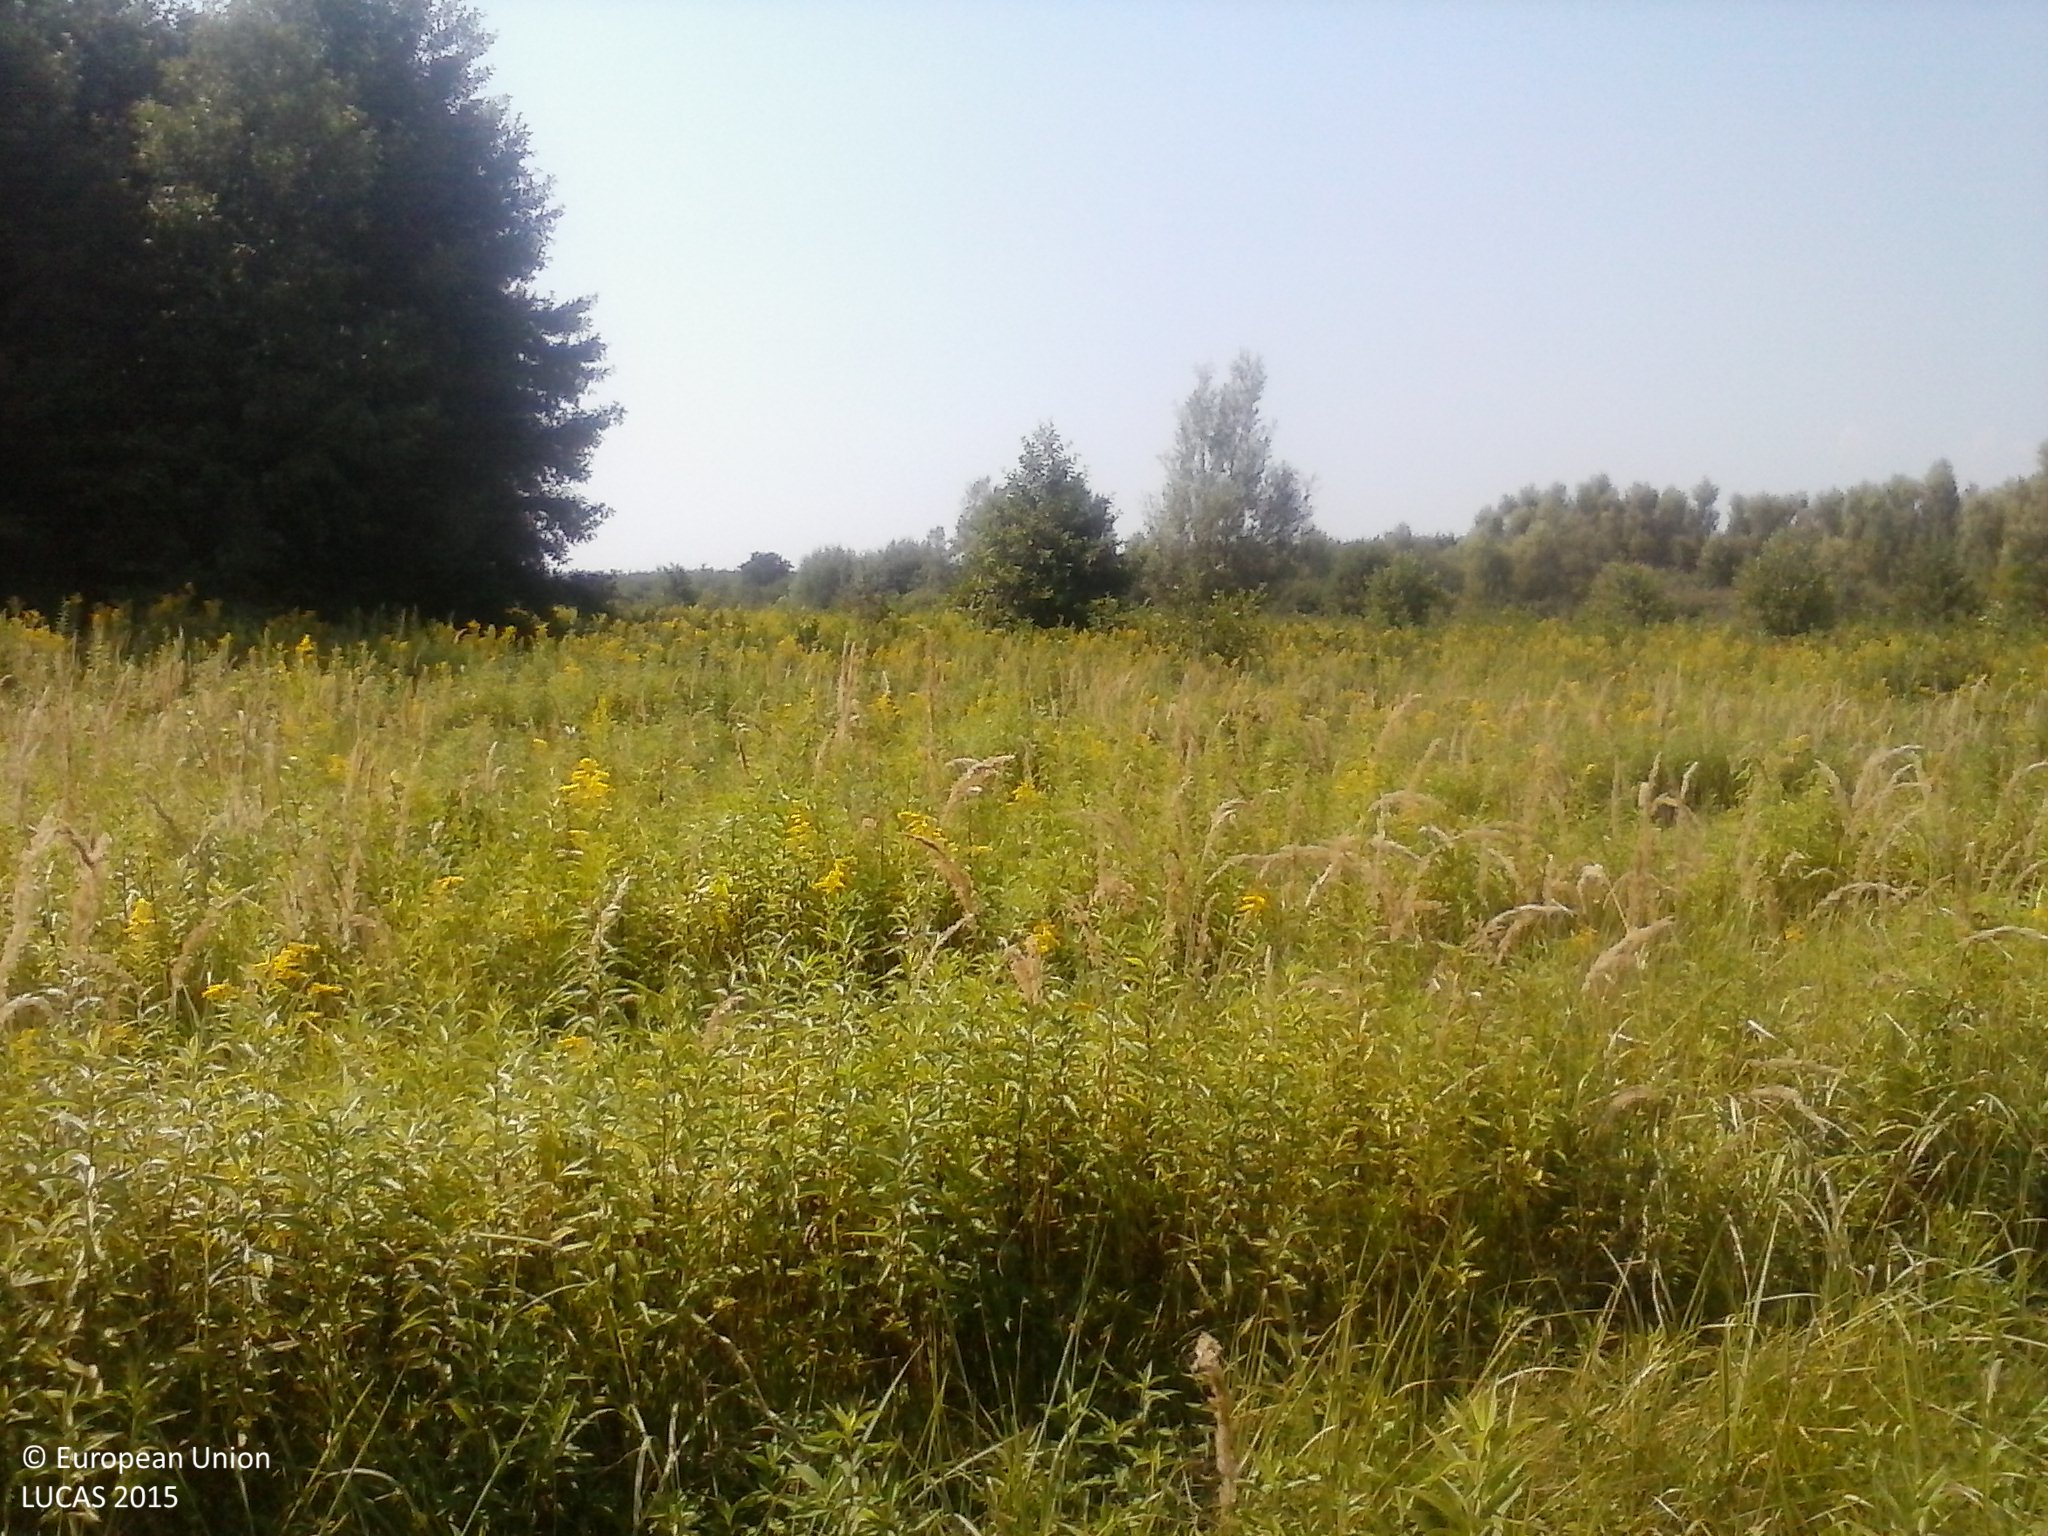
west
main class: Woodland
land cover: Broadleaved woodland
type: acidophilous oak and oak-birch forest
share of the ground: 10 - 25 %
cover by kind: herbaceous plants 80 %, broadleaved forest trees 10 %, shrubs 10 %
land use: Forestry
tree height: < 5 m
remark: Nursery
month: August
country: HU
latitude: 45.8021
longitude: 17.9433
